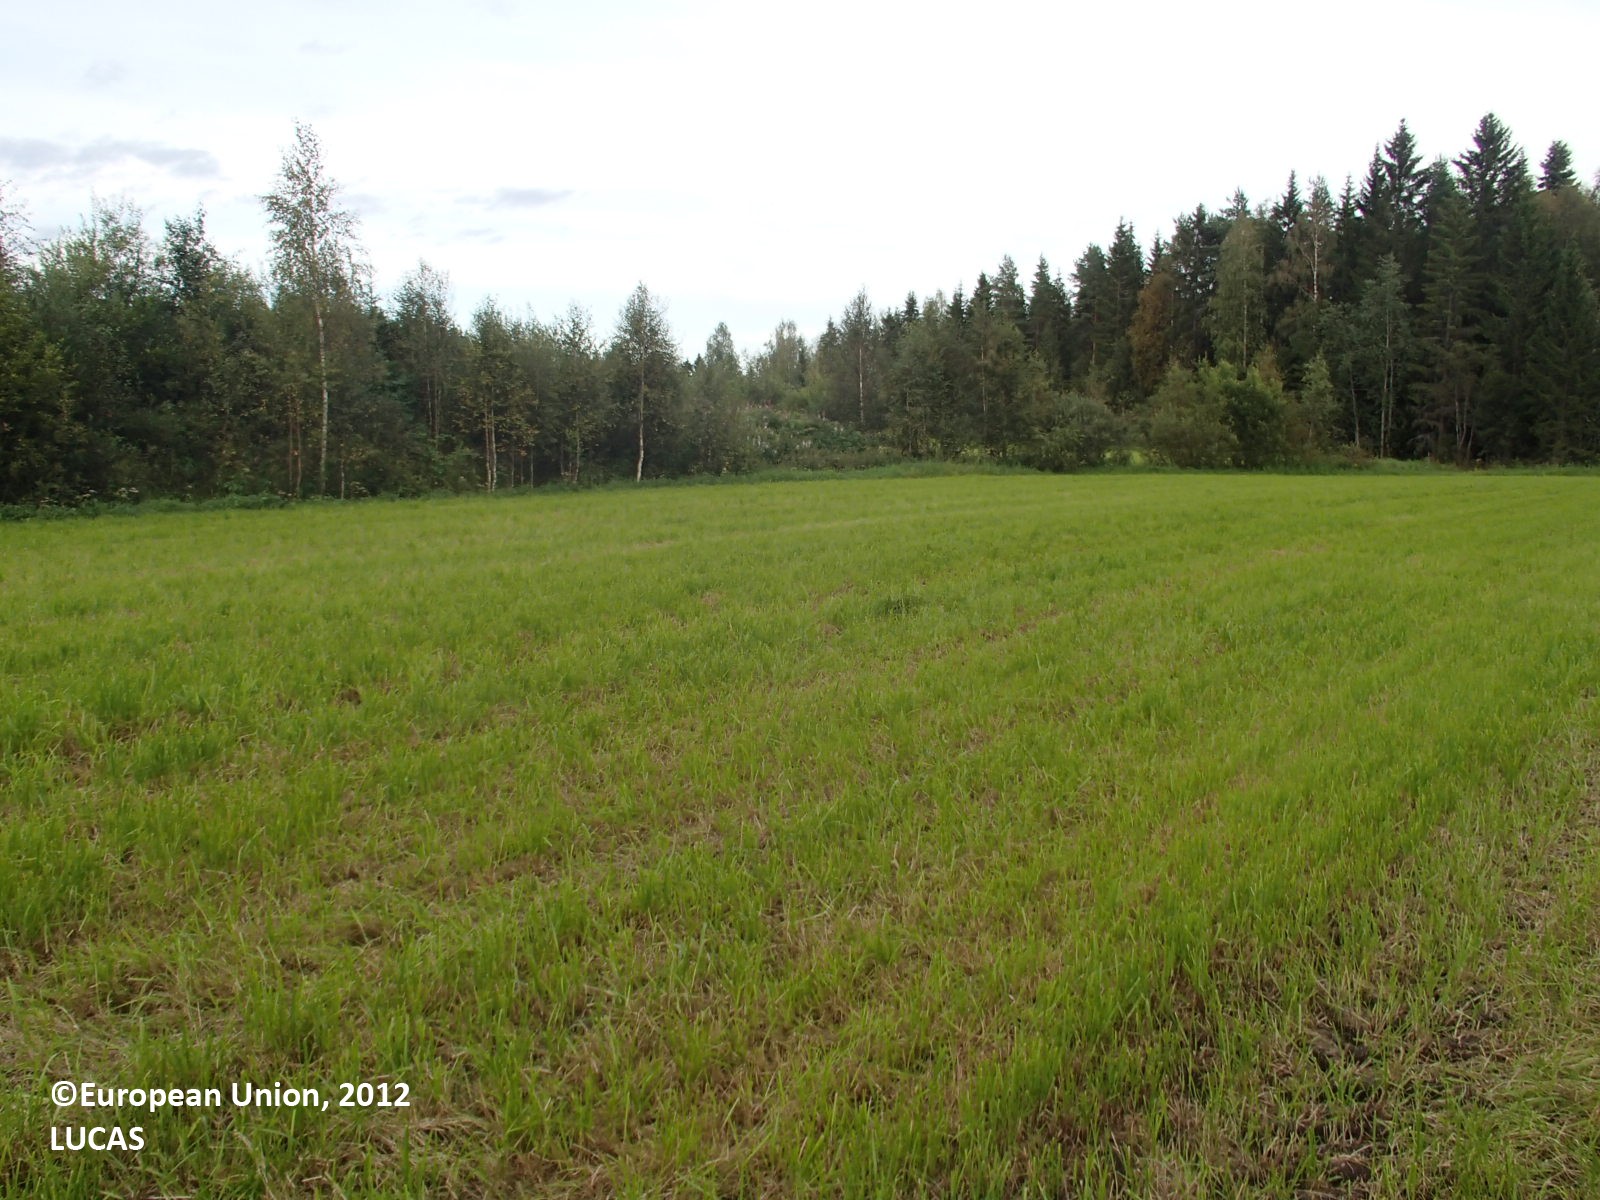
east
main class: Cropland
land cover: Temporary grasslands
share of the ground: > 75 %
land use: Agriculture (excluding fallow land and kitchen gardens)
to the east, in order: Temporary grasslands; Grass margins; Ditches and canals; Spontaneously vegetated surfaces; Temporary grasslands; Abandoned hedges; Ditches and canals; Grass margins; Temporary grasslands; Grass margins; Ditches and canals; Spruce dominated mixed woodland
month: August
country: FI
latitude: 63.3959
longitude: 27.9656
